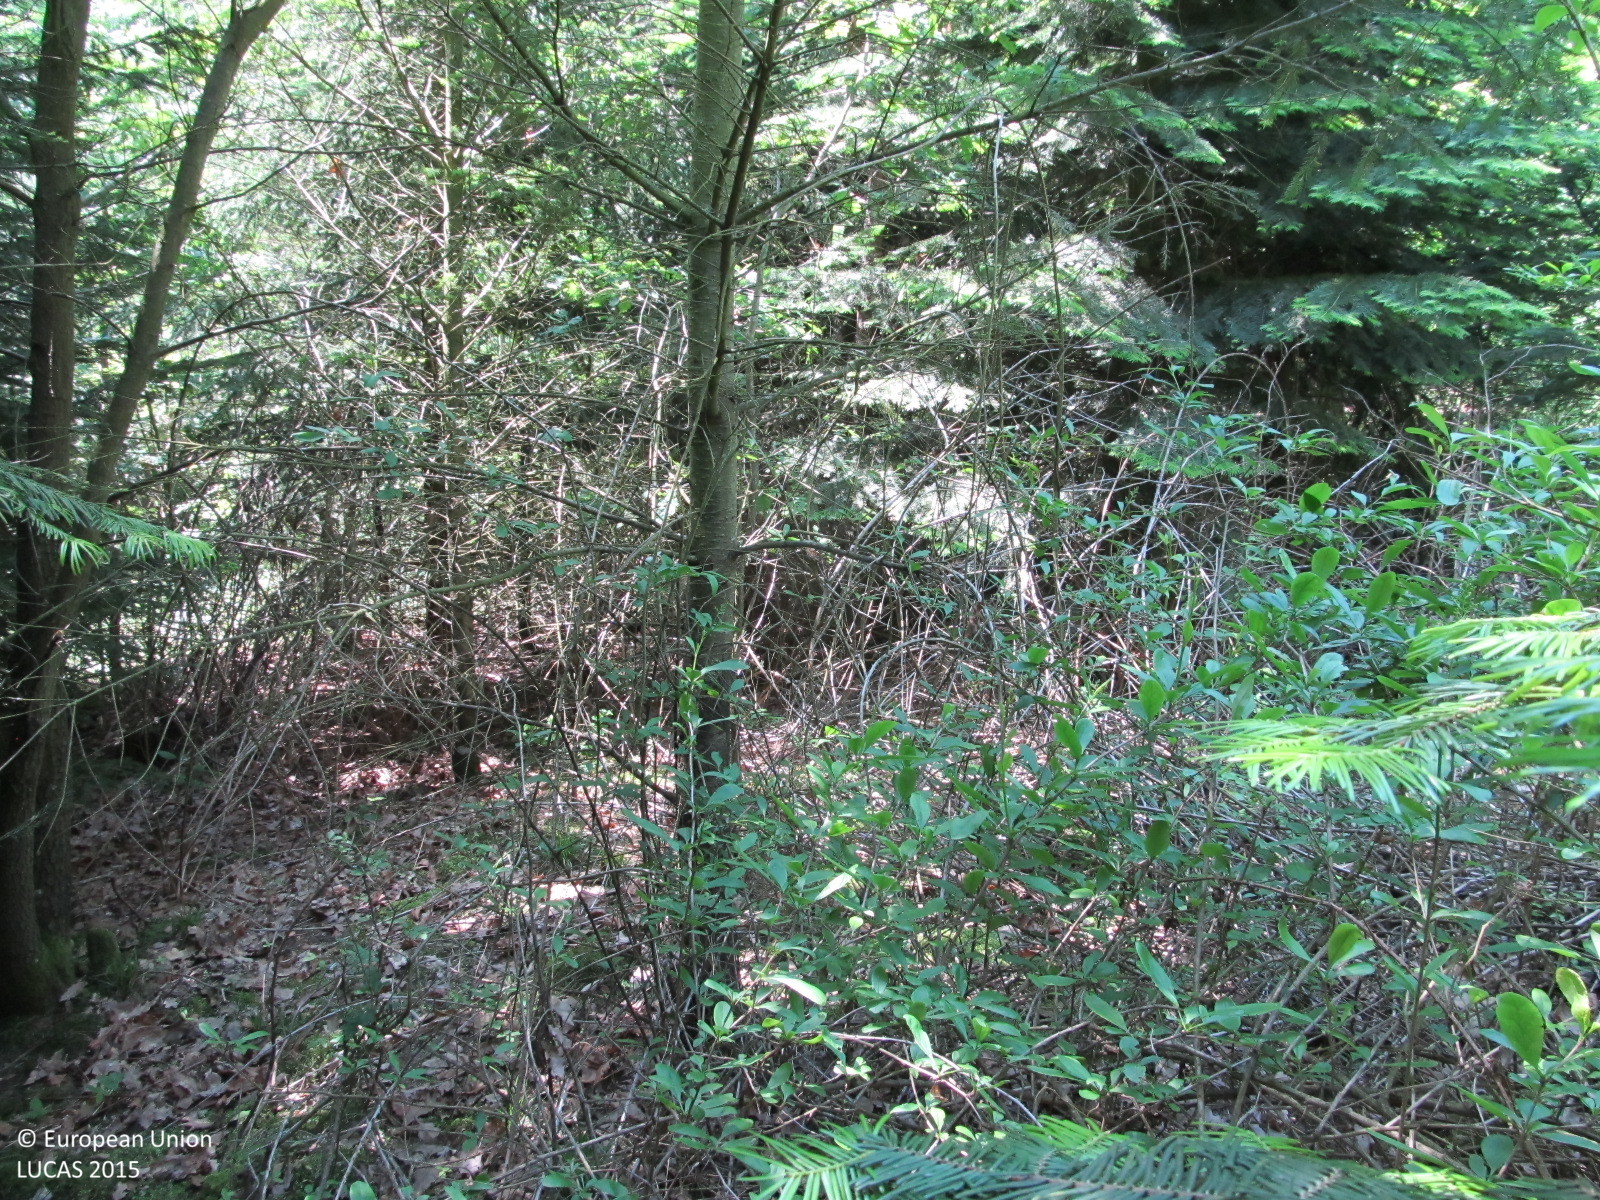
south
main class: Woodland
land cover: Other mixed woodland
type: hemiboreal forest and nemoral coniferous forest and mixed broadleaved-coniferous forest
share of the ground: > 75 %
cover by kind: coniferous forest trees 50 %, broadleaved forest trees 30 %, shrubs 10 %, herbaceous plants 10 %
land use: Forestry
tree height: > 5 m
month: May
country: AT
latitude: 48.6910
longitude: 15.6684
